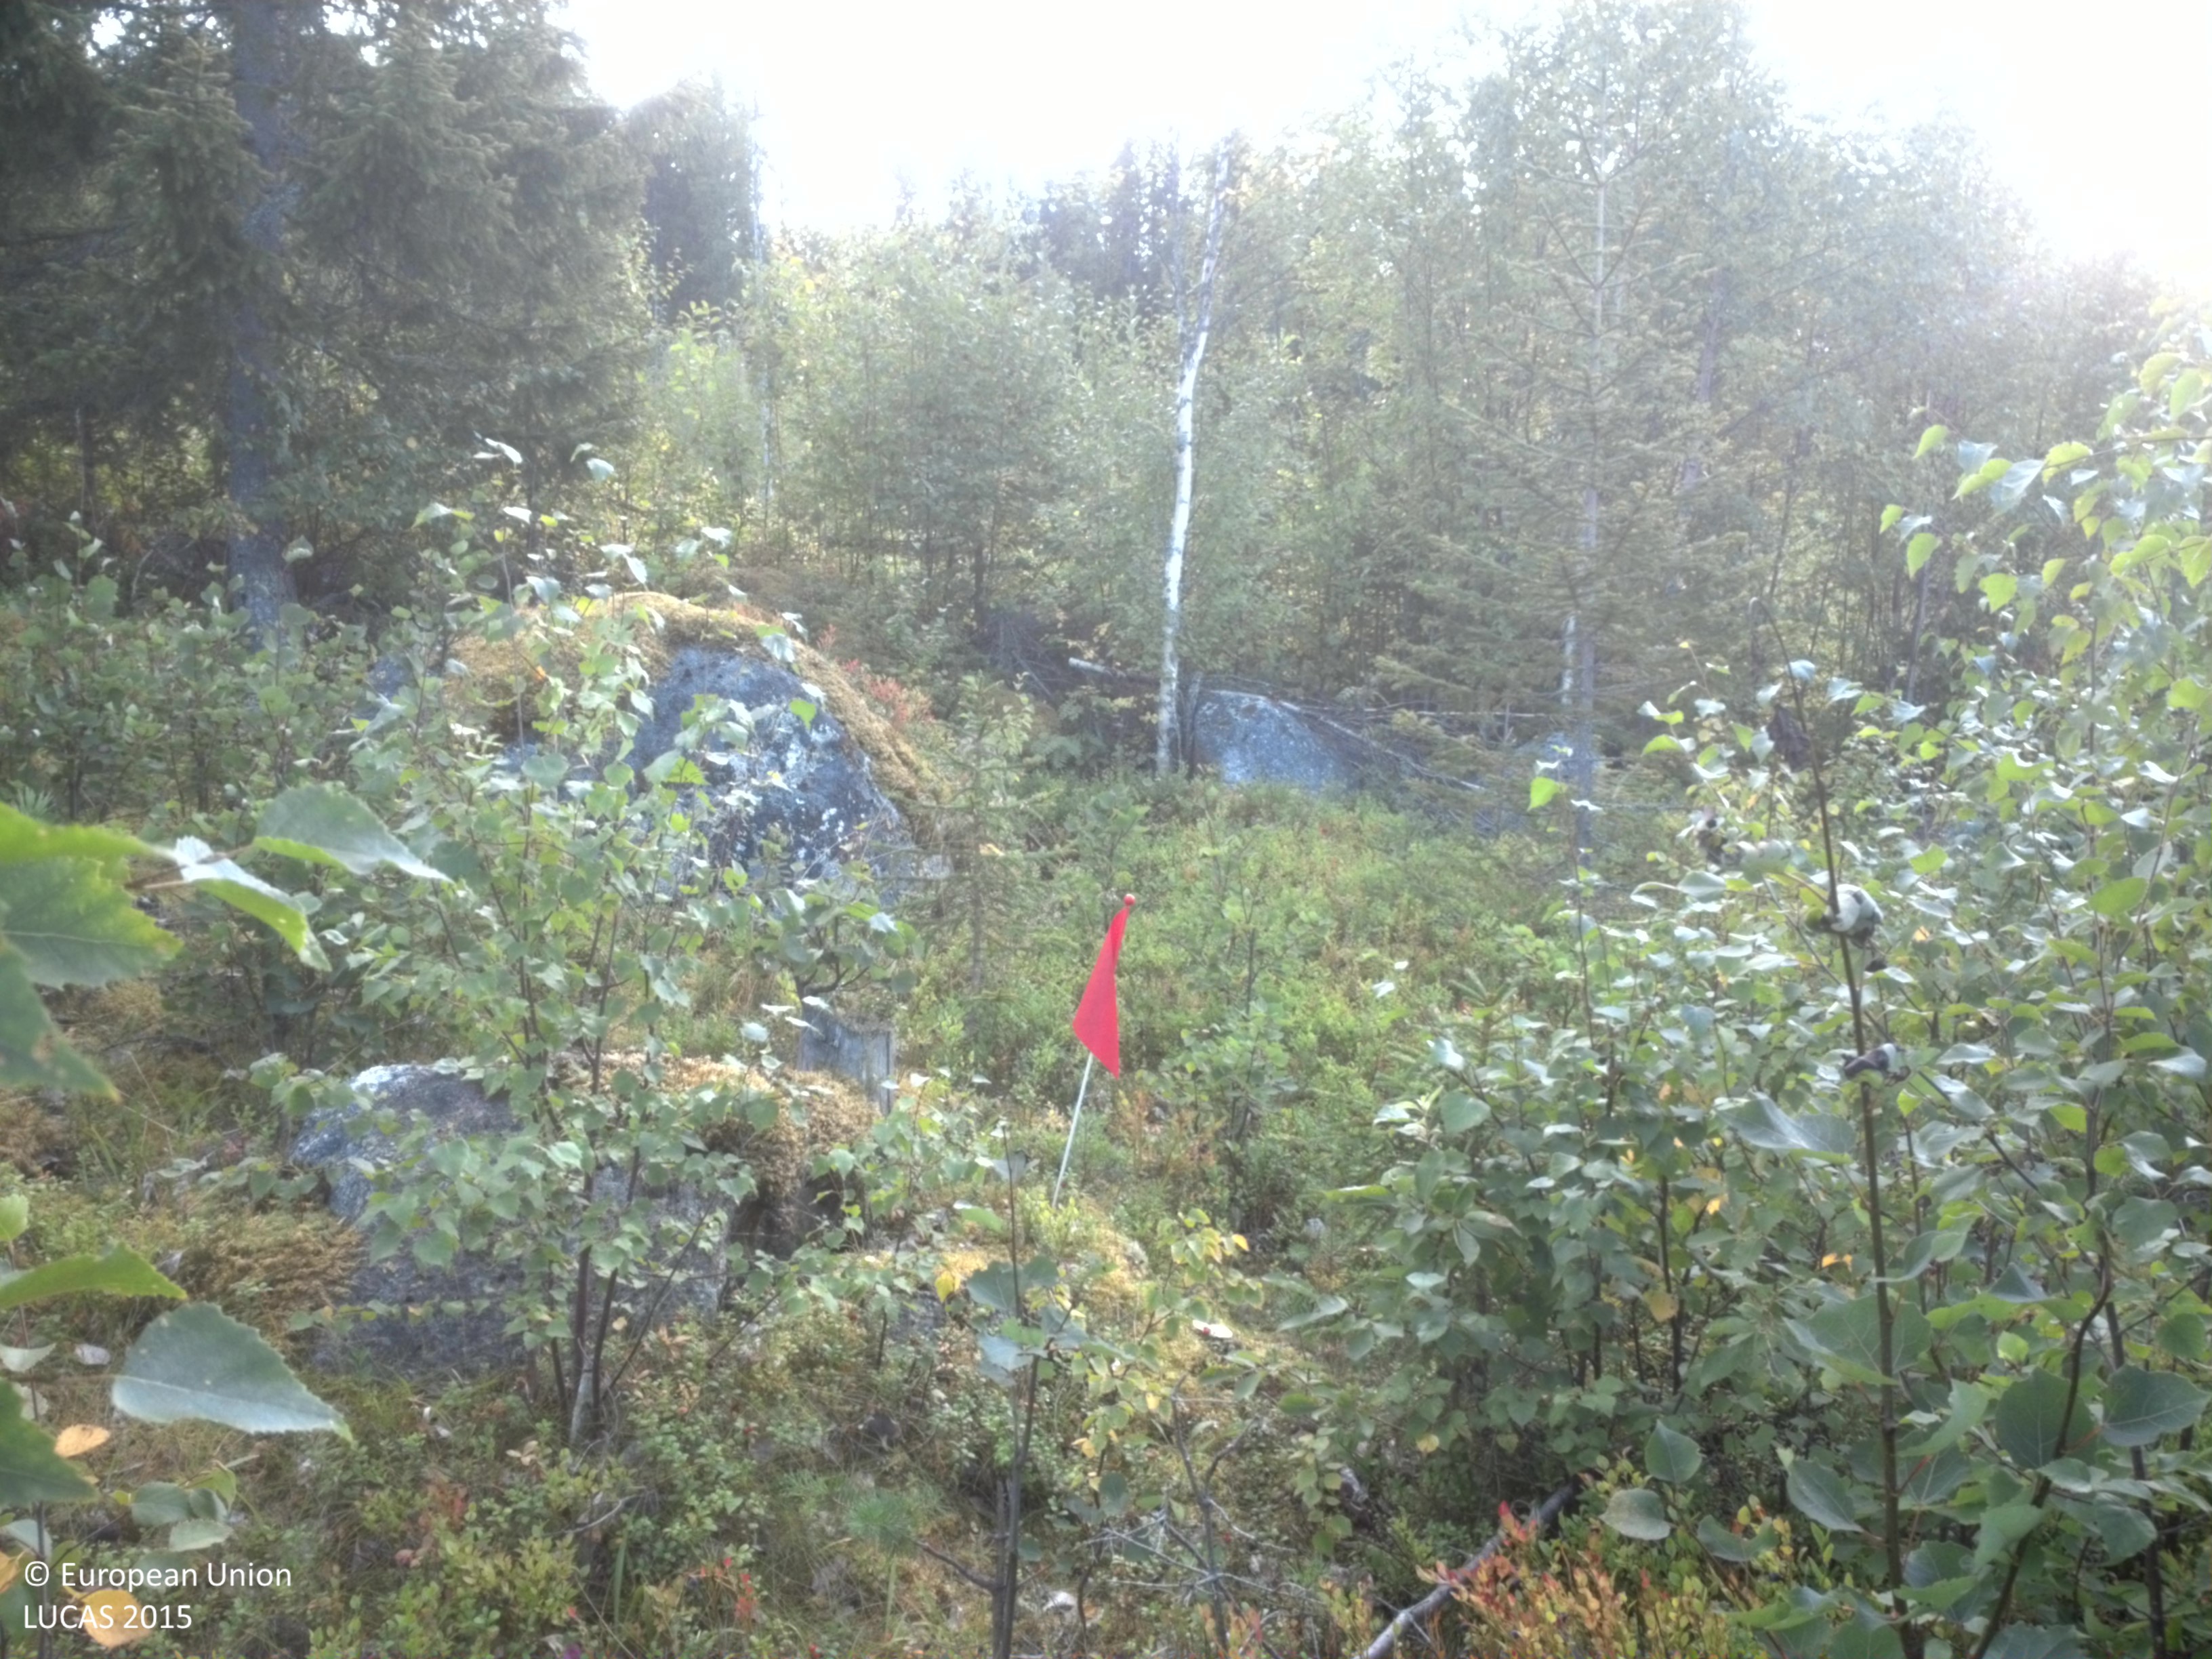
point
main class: Woodland
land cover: Broadleaved woodland
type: boreal forest
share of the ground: 50 - 75 %
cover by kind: broadleaved forest trees 60 %, shrubs 15 %, coniferous forest trees 10 %, lichens and mosses 10 %, herbaceous plants 5 %
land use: Forestry
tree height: > 5 m
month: September
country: SE
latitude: 64.4309
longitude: 19.0452
